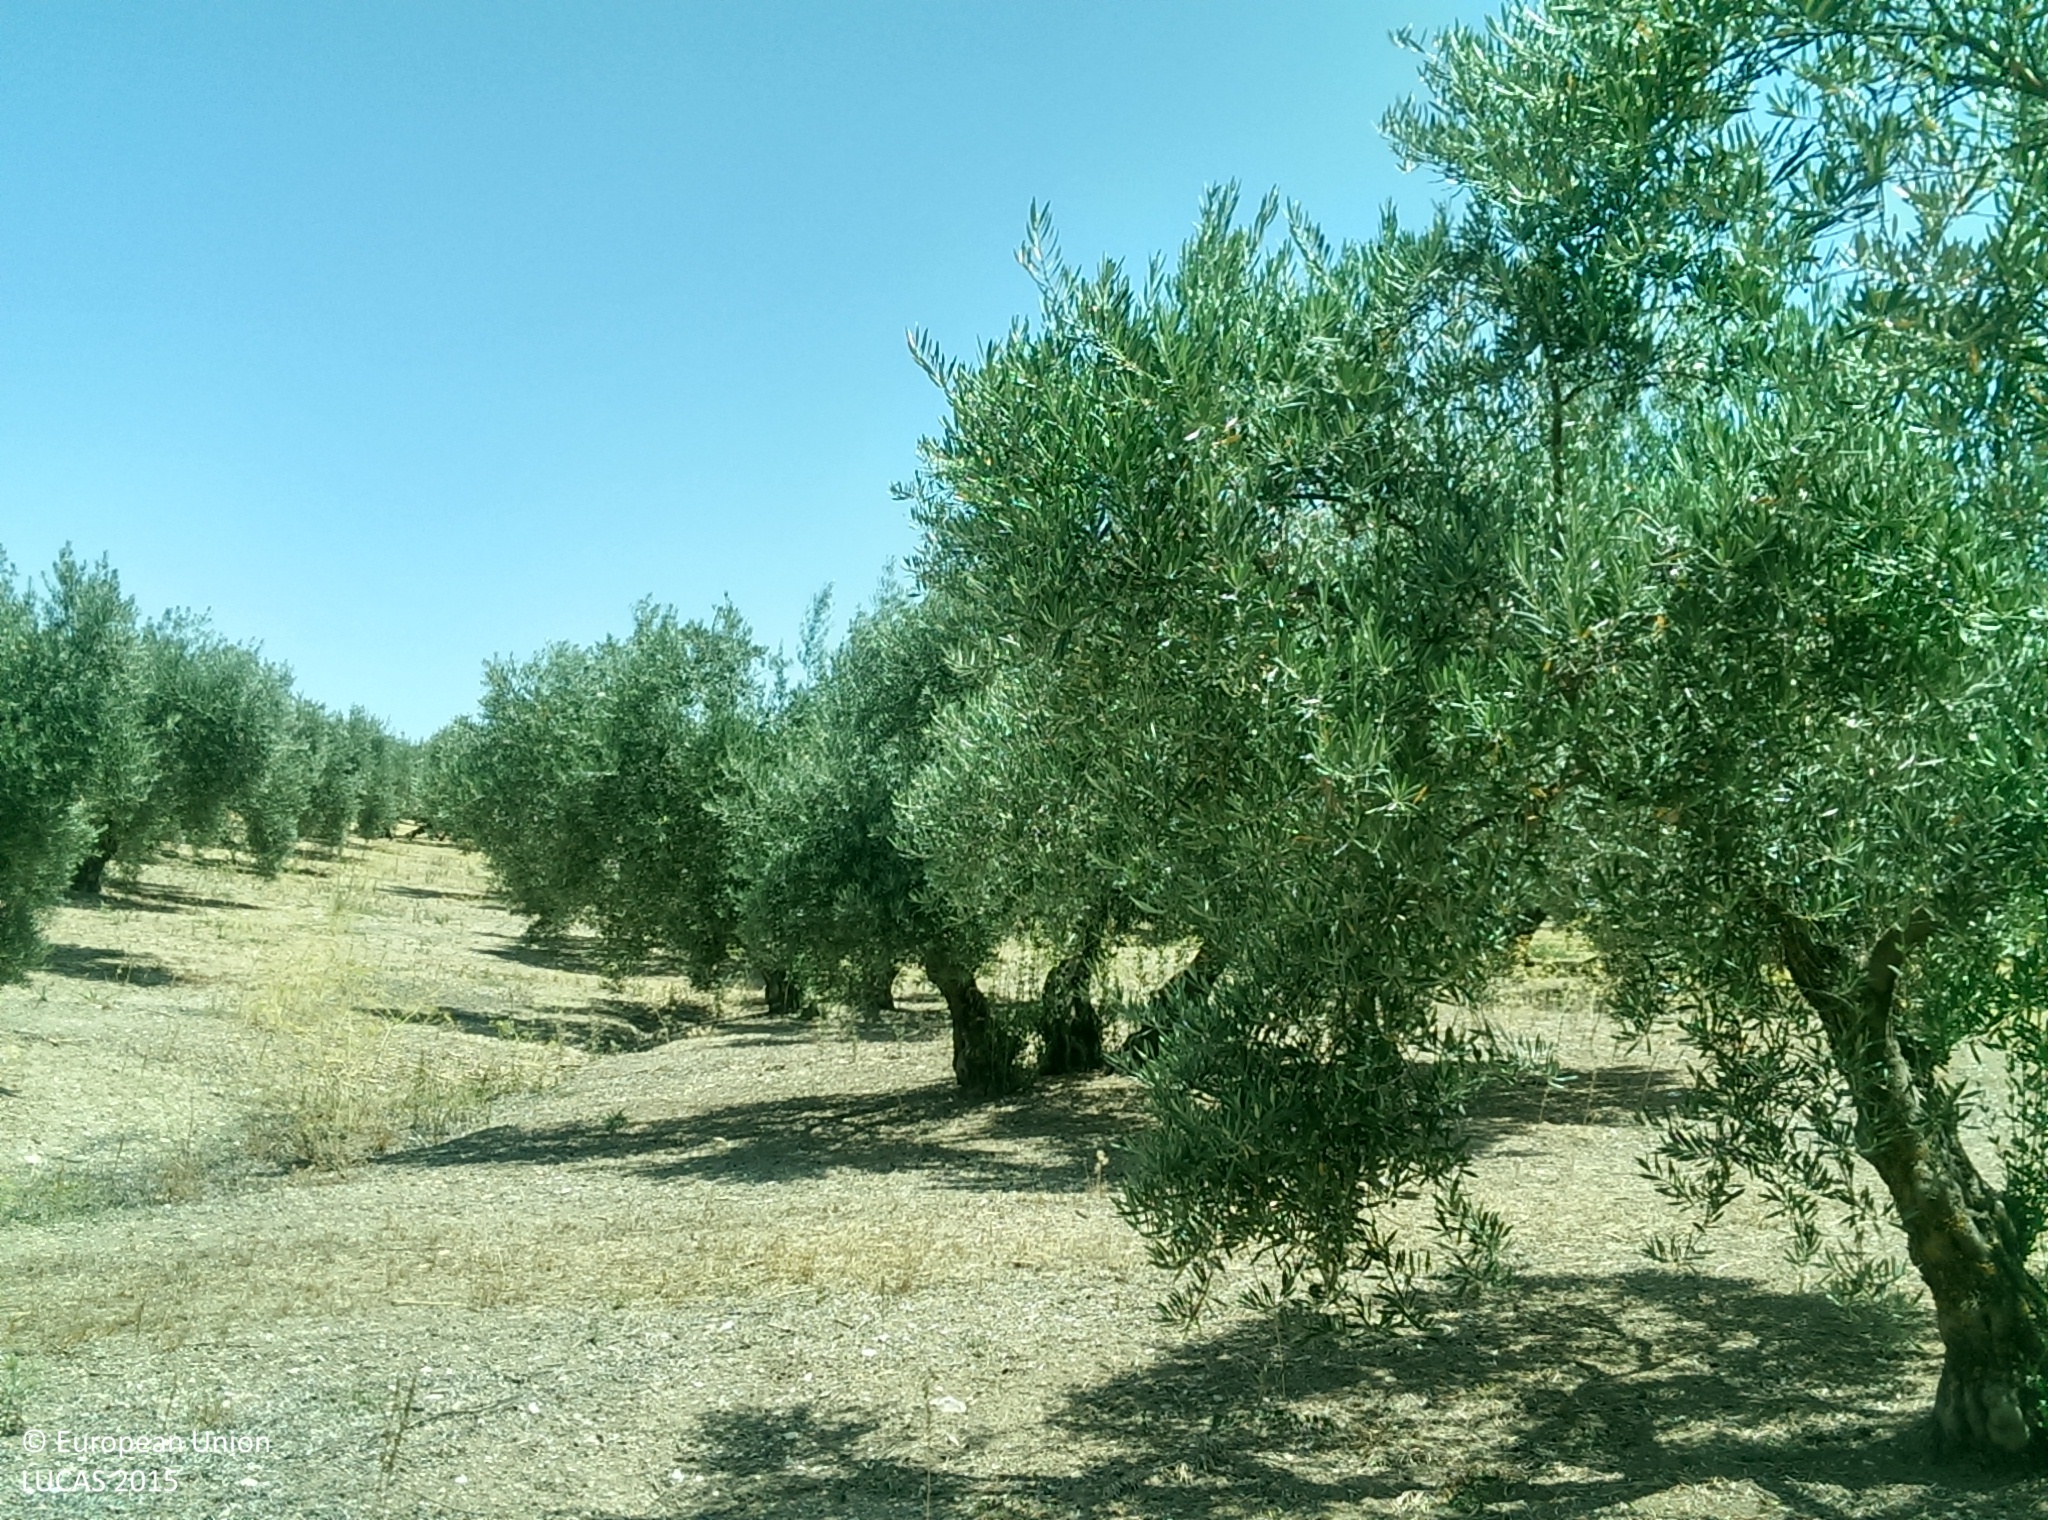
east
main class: Cropland
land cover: Olive groves
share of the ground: 50 - 75 %
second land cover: Spontaneously vegetated surfaces
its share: 10 - 25 %
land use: Agriculture (excluding fallow land and kitchen gardens)
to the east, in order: Olive groves; Spontaneously vegetated surfaces; Tracks; Olive groves
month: July
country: ES
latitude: 37.4090
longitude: -3.7210
